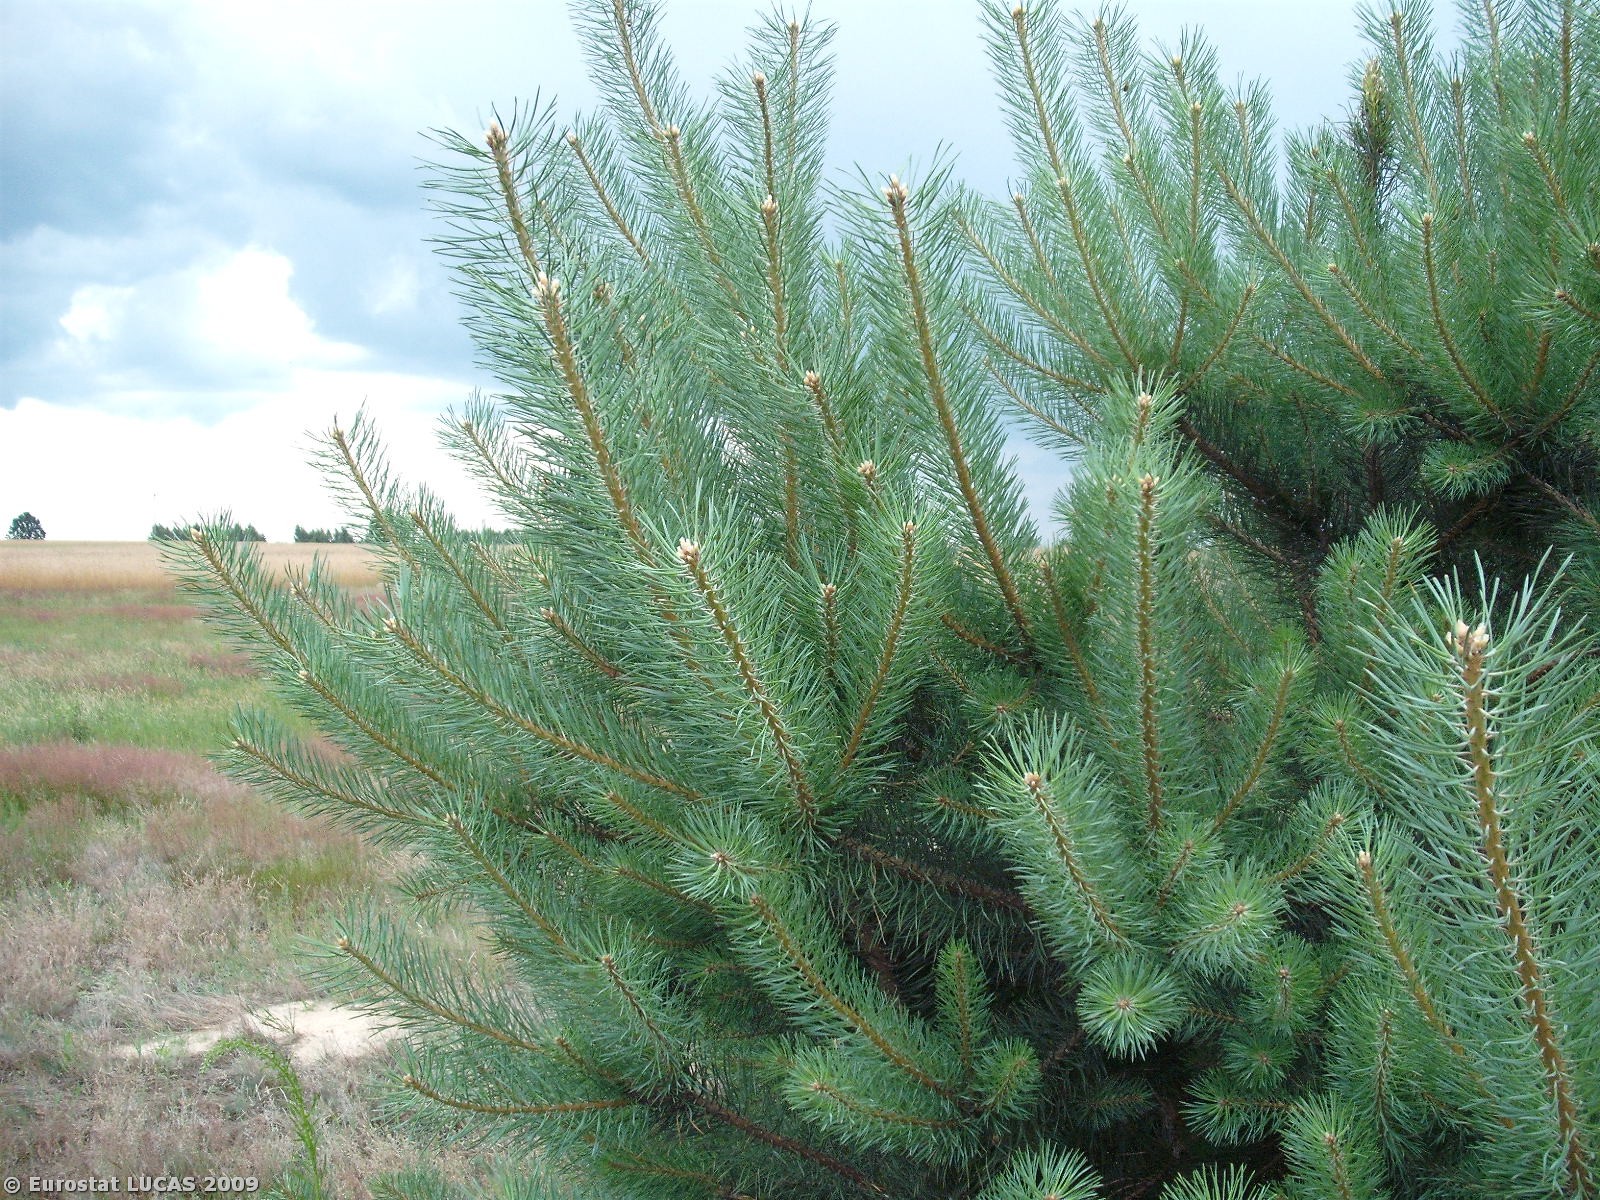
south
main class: Grassland
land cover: Grassland with sparse tree/shrub cover
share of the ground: > 75 %
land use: Unused
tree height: < 5 m
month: July
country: PL
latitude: 51.4777
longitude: 21.0601
